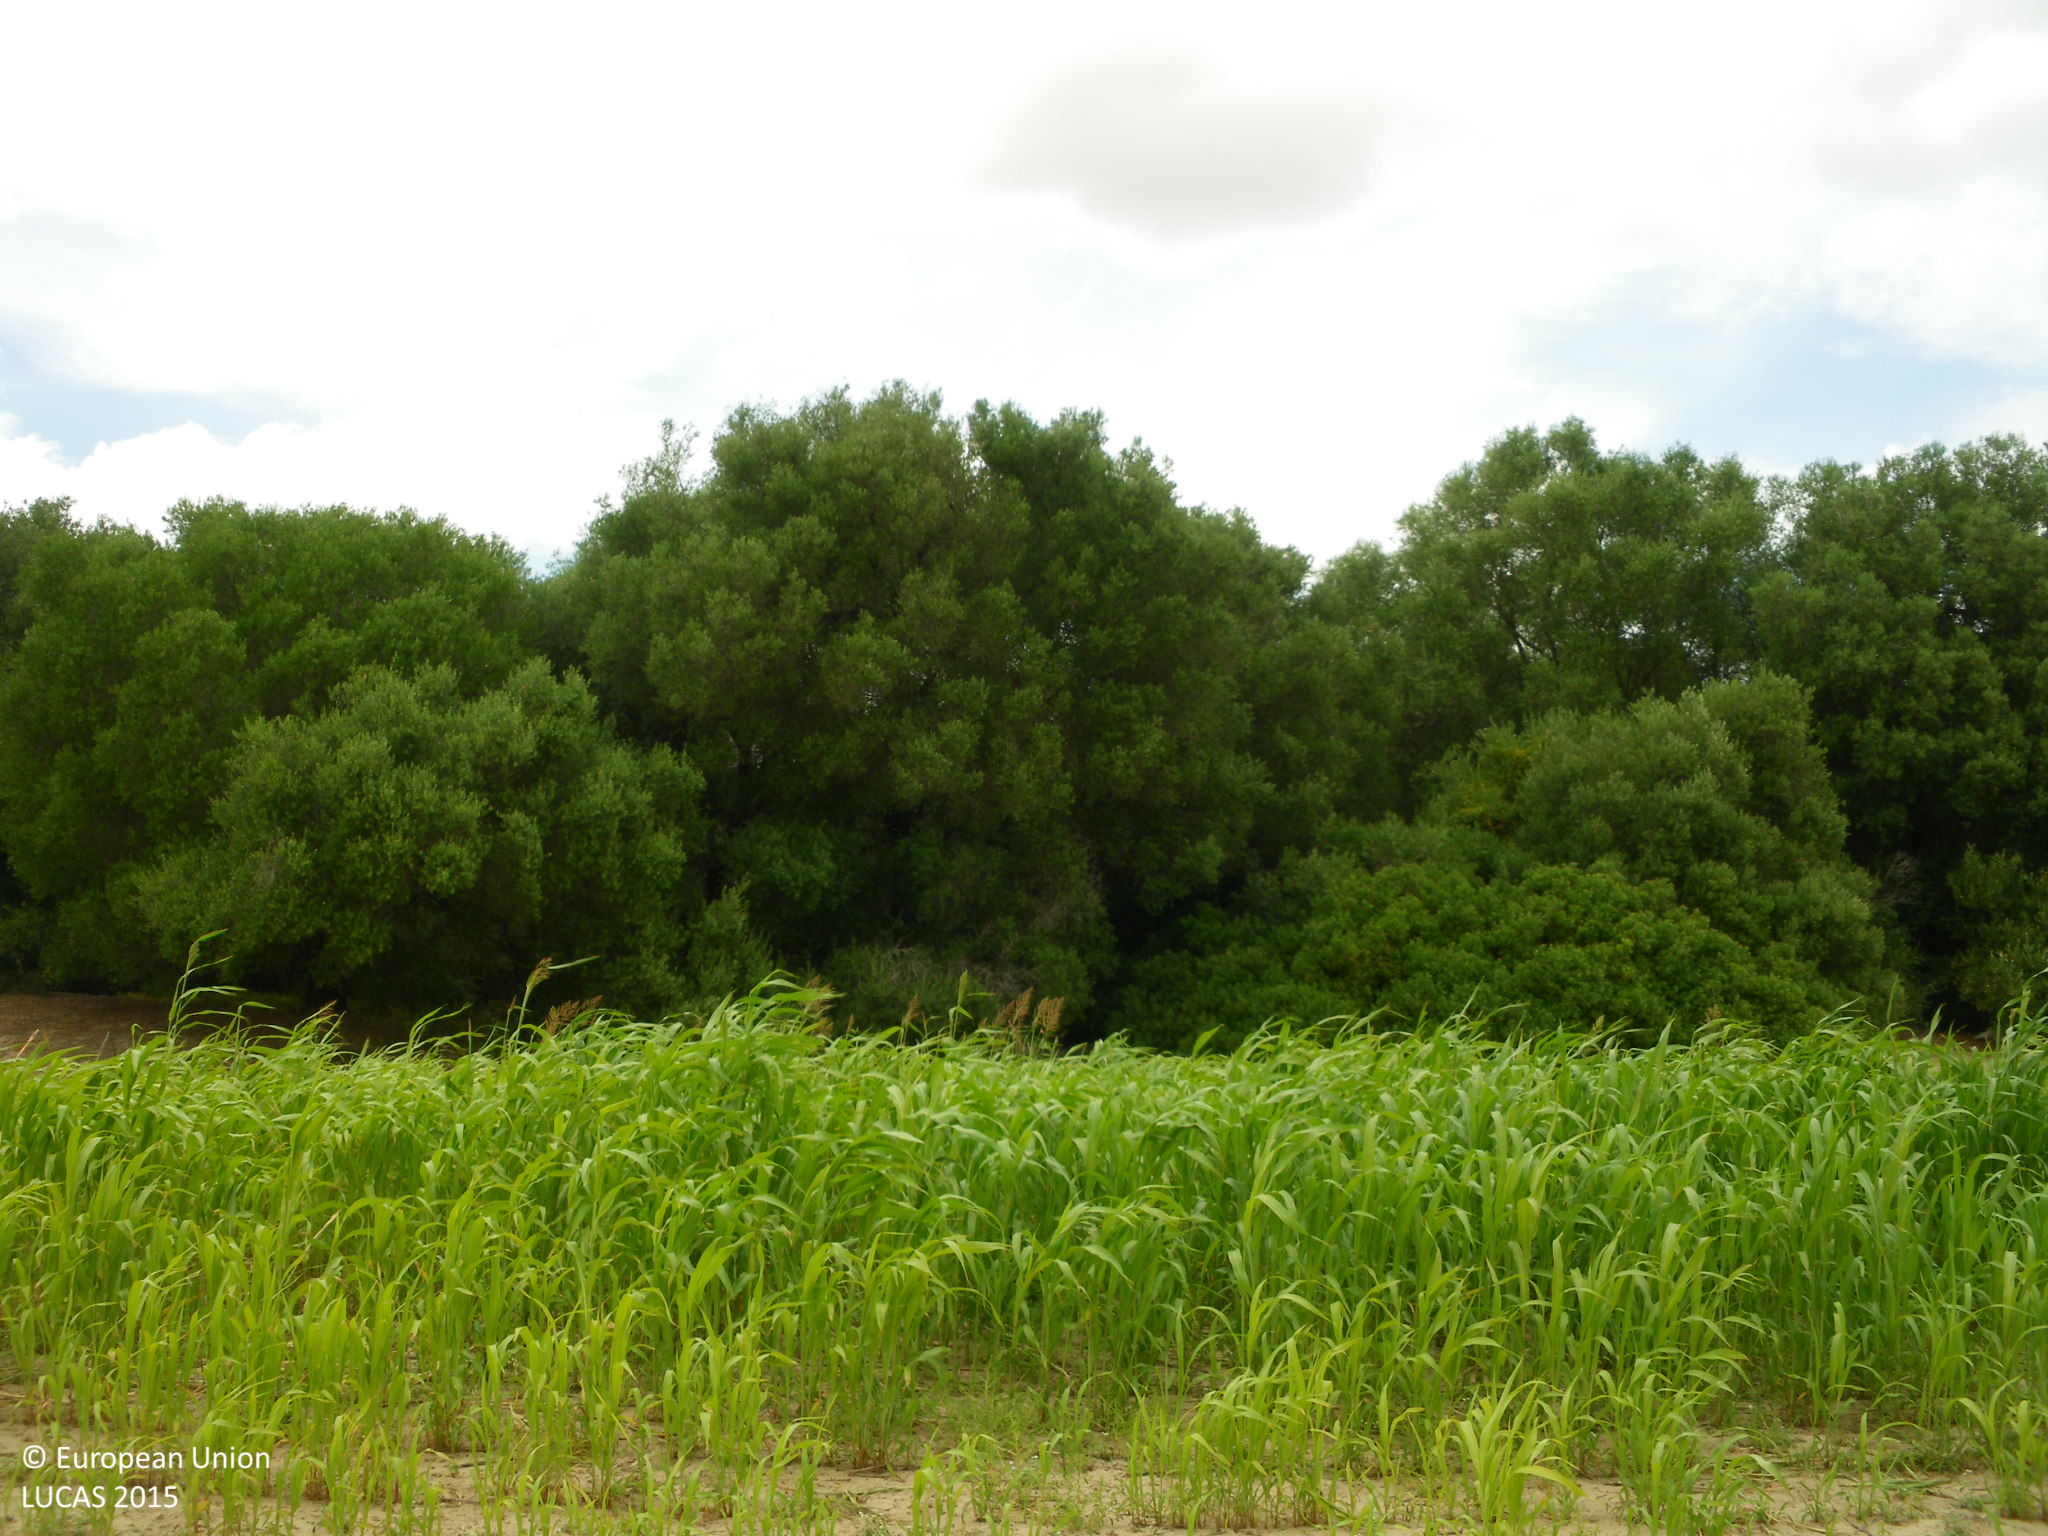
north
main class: Cropland
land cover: Other cereals
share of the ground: < 10 %
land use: Agriculture (excluding fallow land and kitchen gardens)
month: June
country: ES
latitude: 36.3309
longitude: -5.8758
